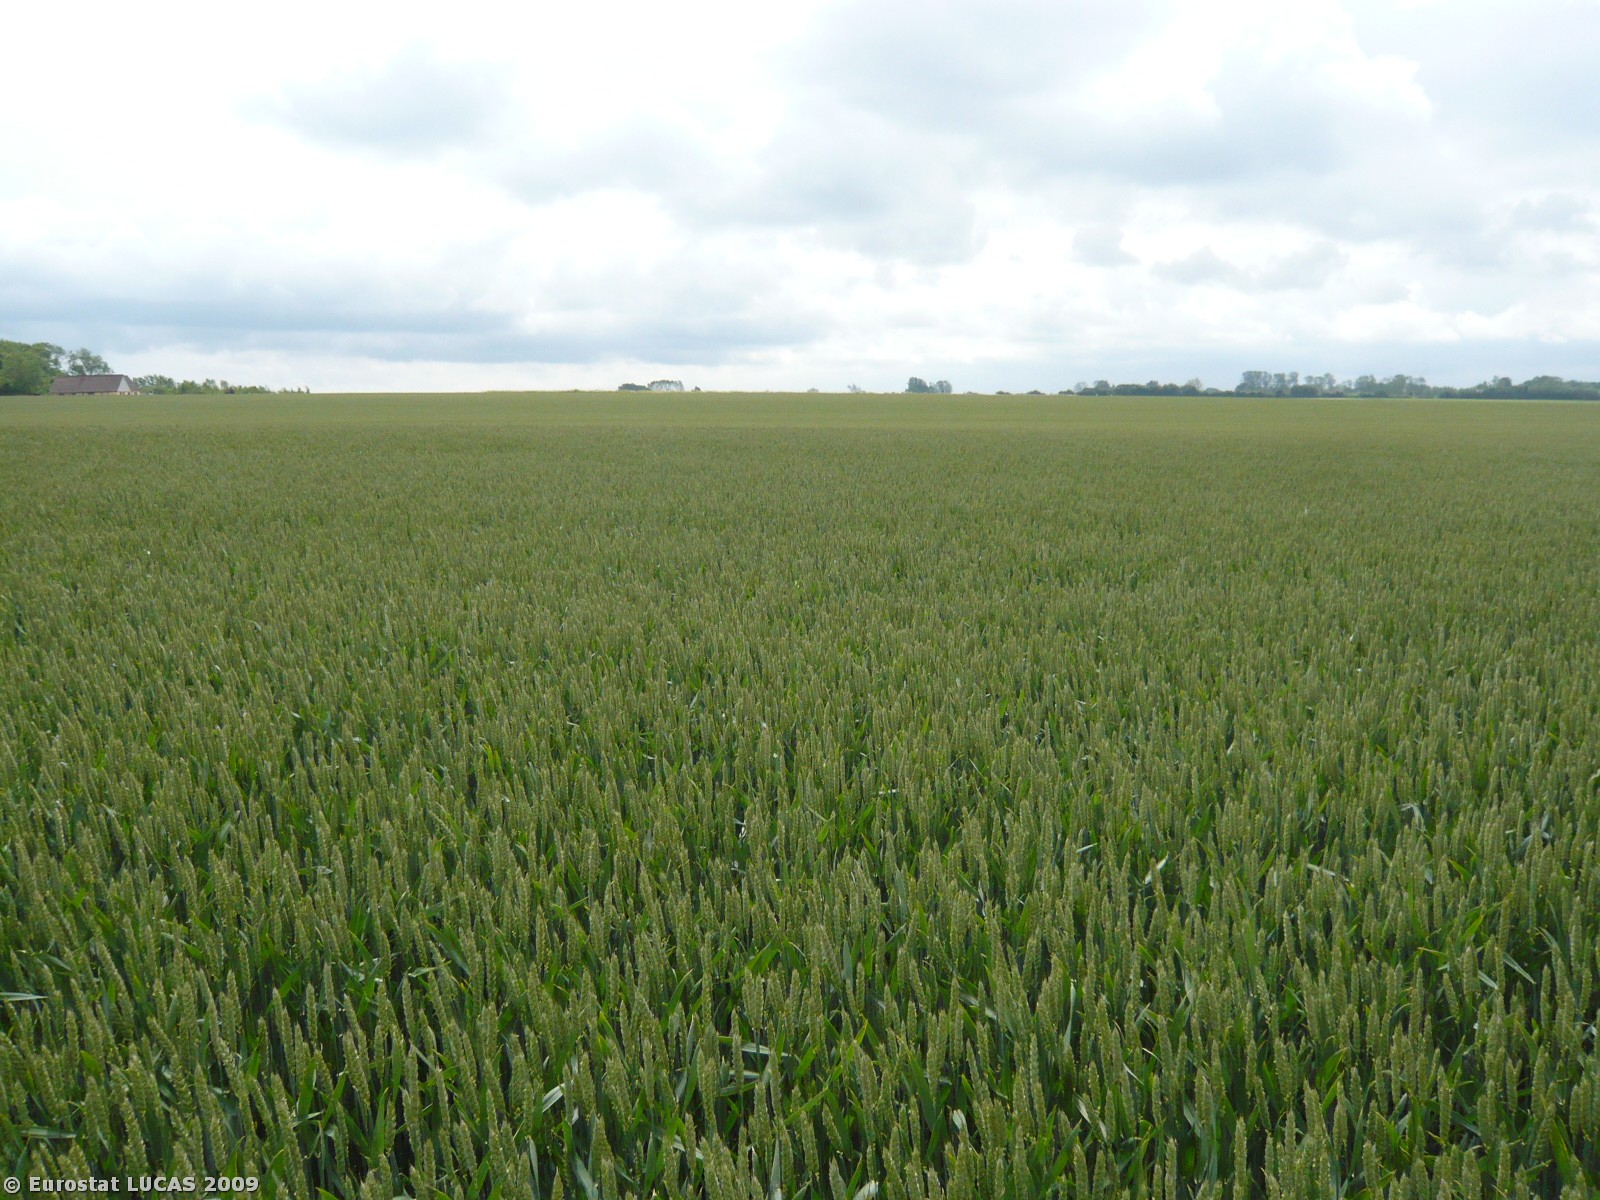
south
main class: Cropland
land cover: Common wheat
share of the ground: > 75 %
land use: Agriculture (excluding fallow land and kitchen gardens)
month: June
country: DK
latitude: 54.8983
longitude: 11.8232
